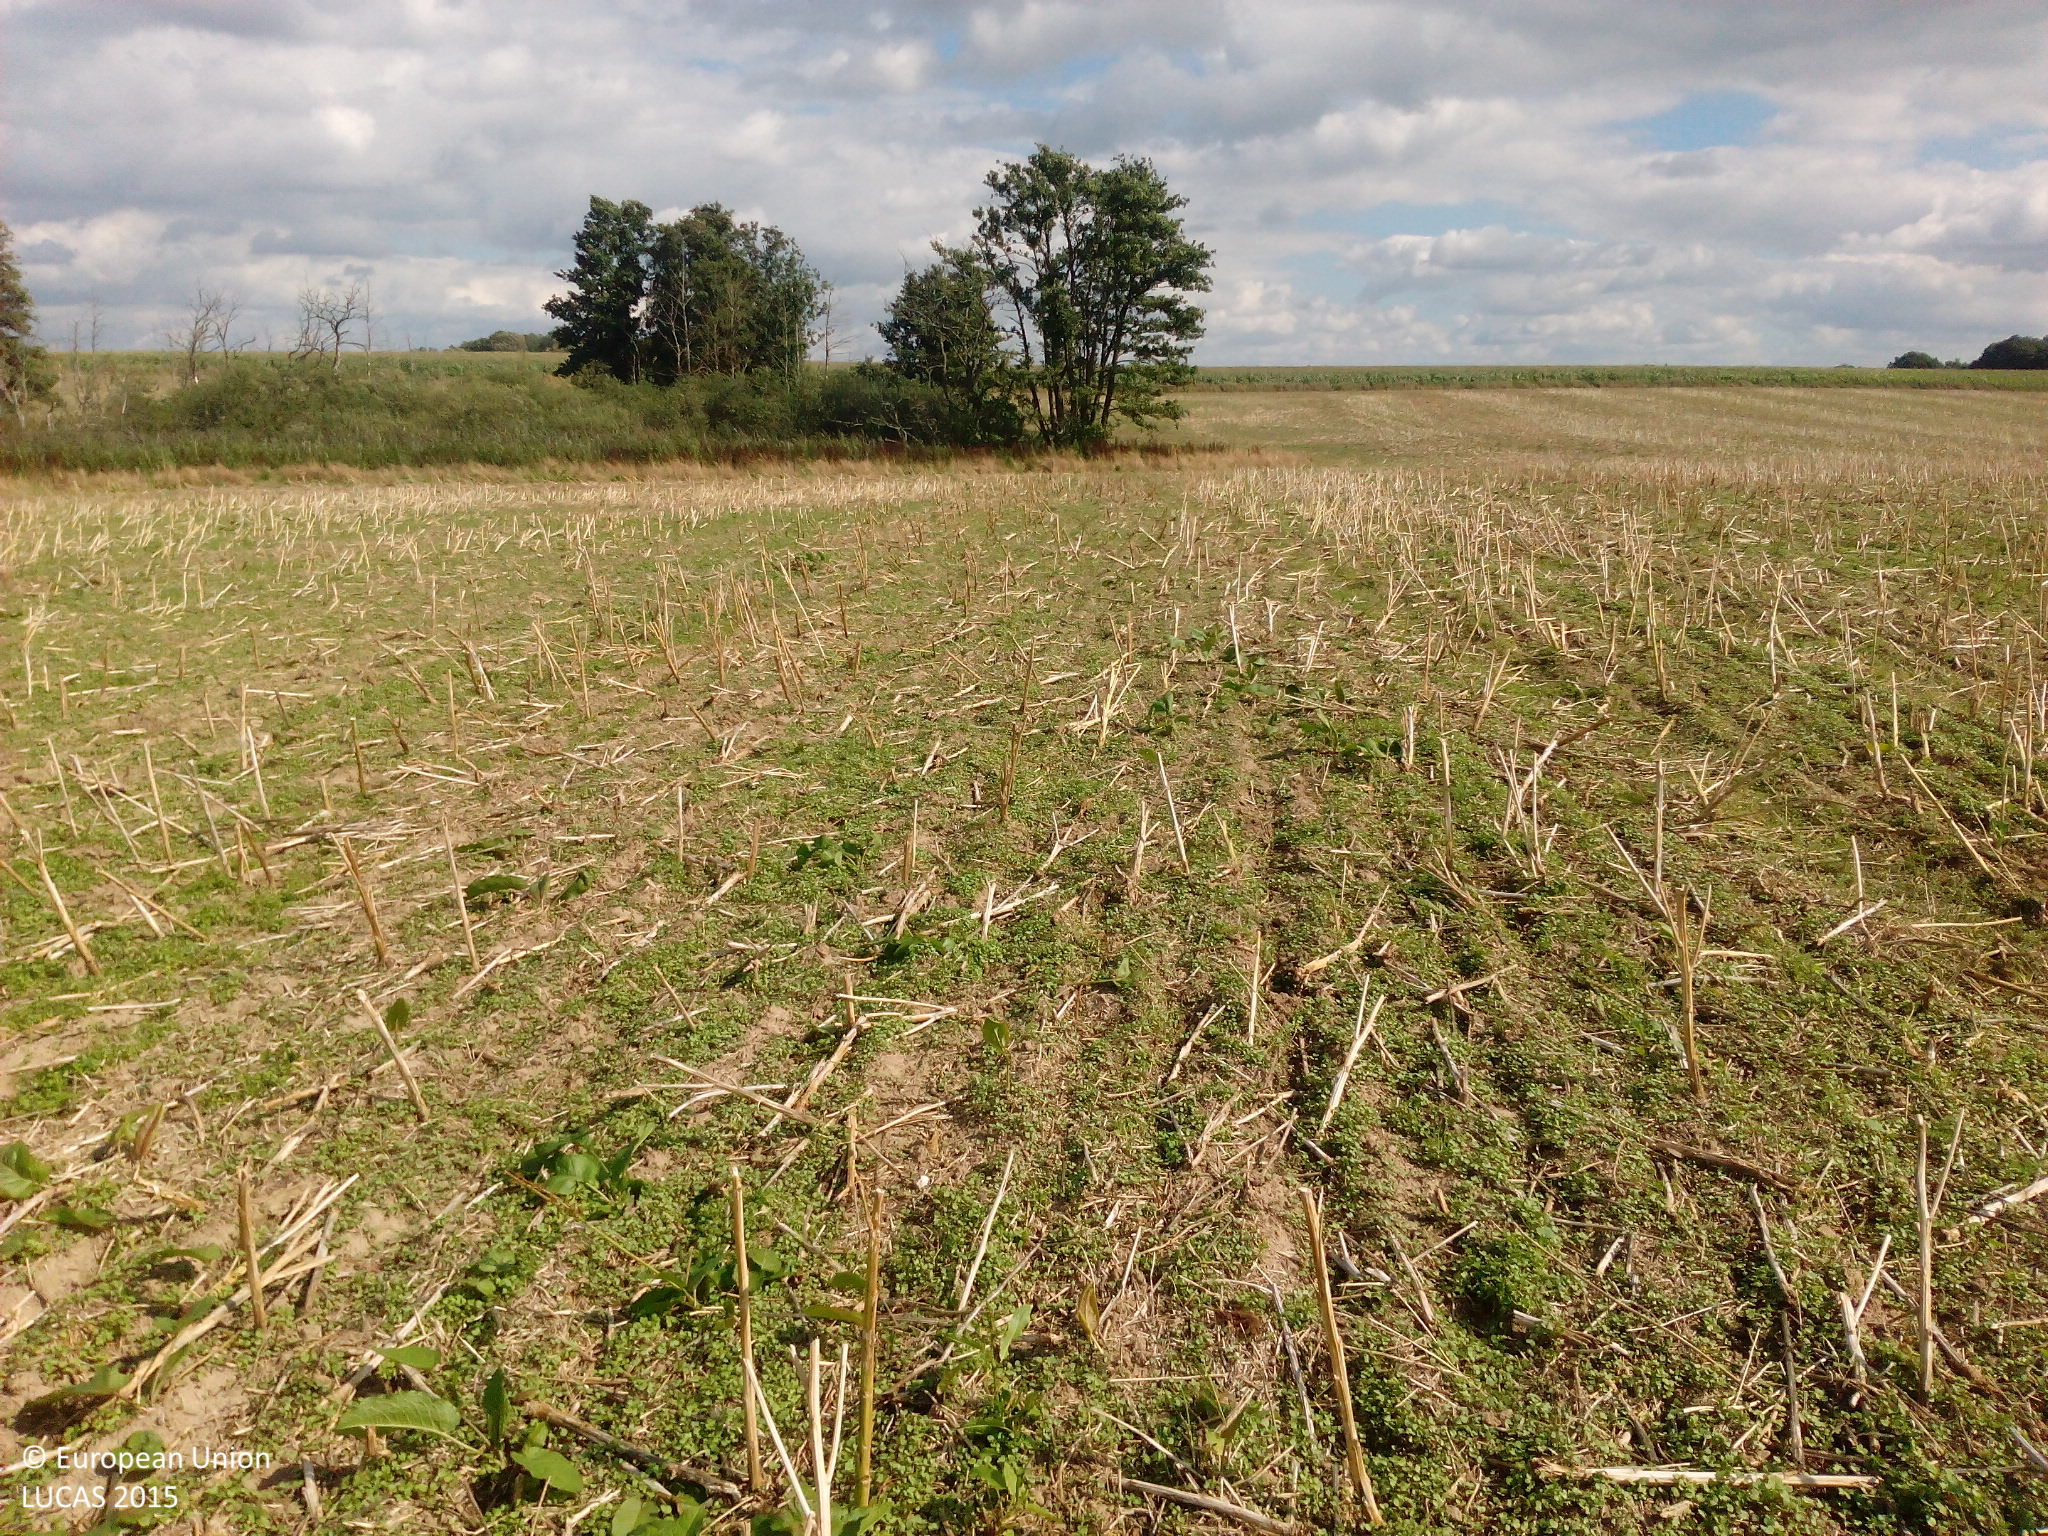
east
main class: Cropland
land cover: Rape and turnip rape
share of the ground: > 75 %
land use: Agriculture (excluding fallow land and kitchen gardens)
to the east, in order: Rape and turnip rape; Spontaneously vegetated surfaces; Inland marshes; Shrubland with sparse tree cover; Broadleaved woodland; Spontaneously vegetated surfaces; Rape and turnip rape; Fences; Maize
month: September
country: DE
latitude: 54.0447
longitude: 12.3357
